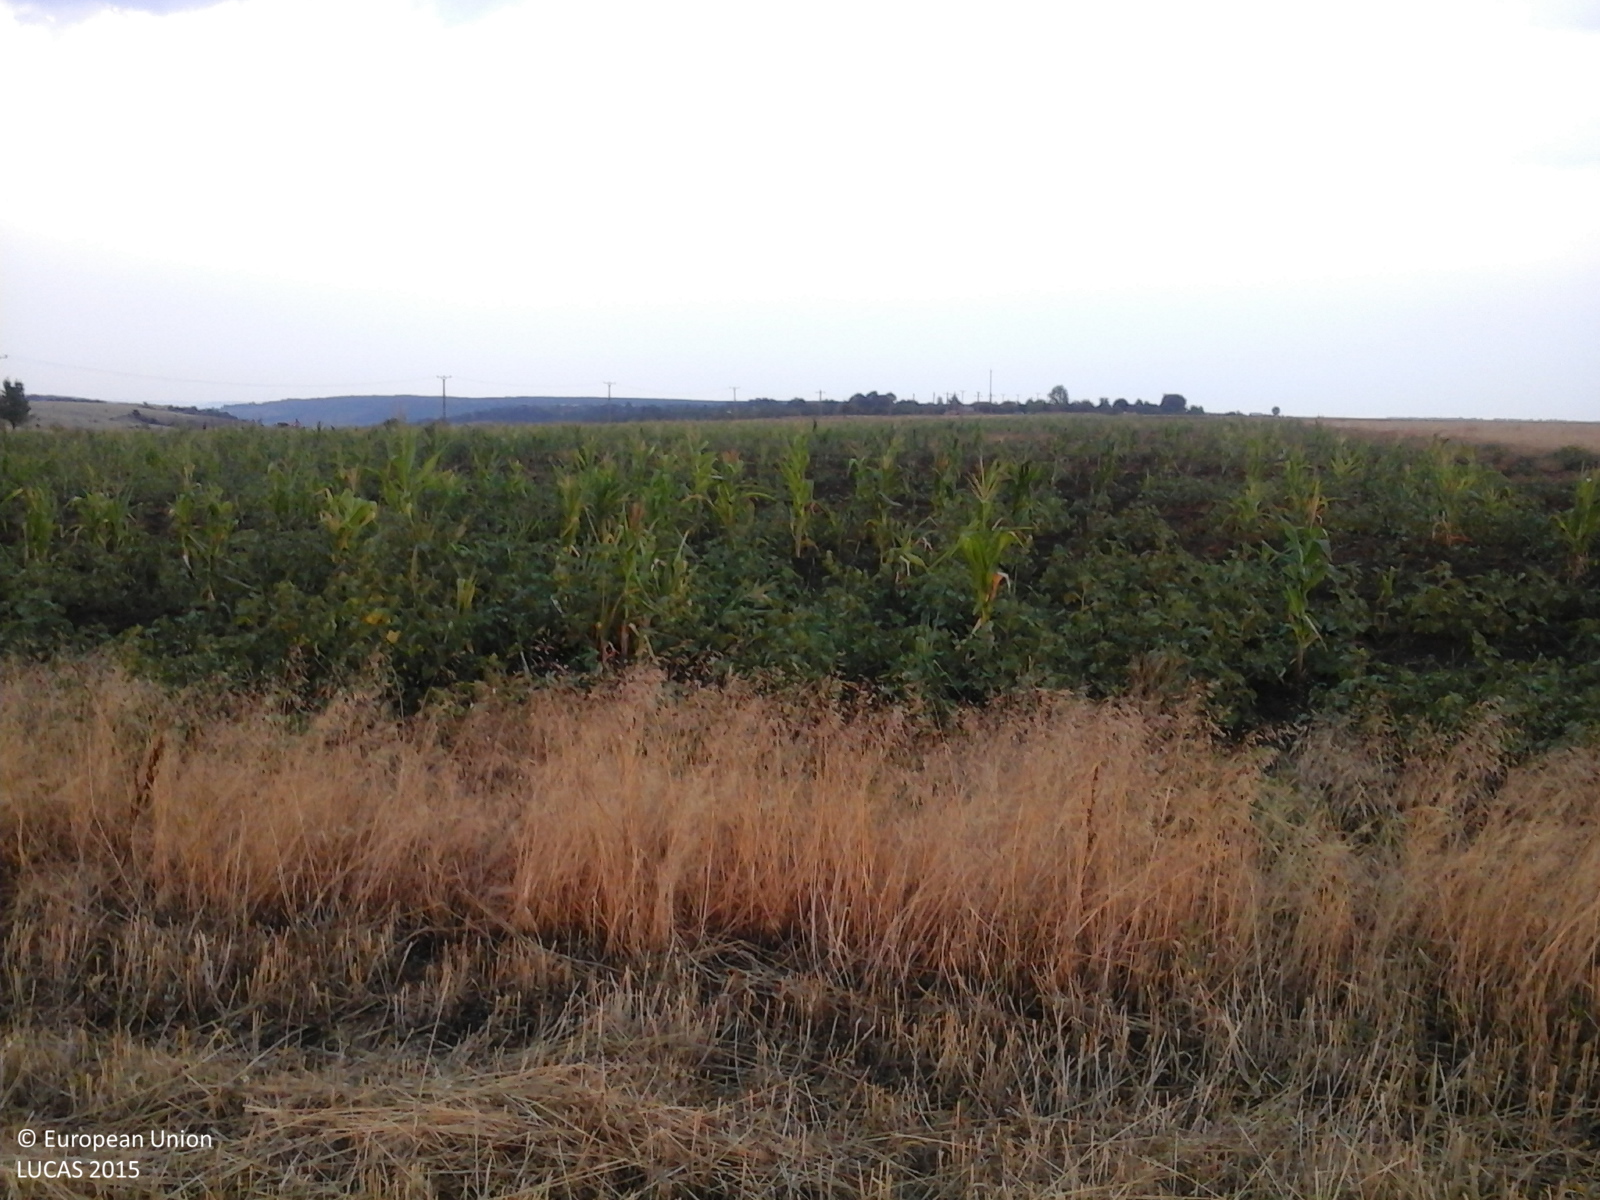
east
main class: Cropland
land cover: Mixed cereals for fodder
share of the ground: > 75 %
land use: Agriculture (excluding fallow land and kitchen gardens)
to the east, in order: Mixed cereals for fodder; Maize
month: August
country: RO
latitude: 44.5332
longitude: 22.9947
